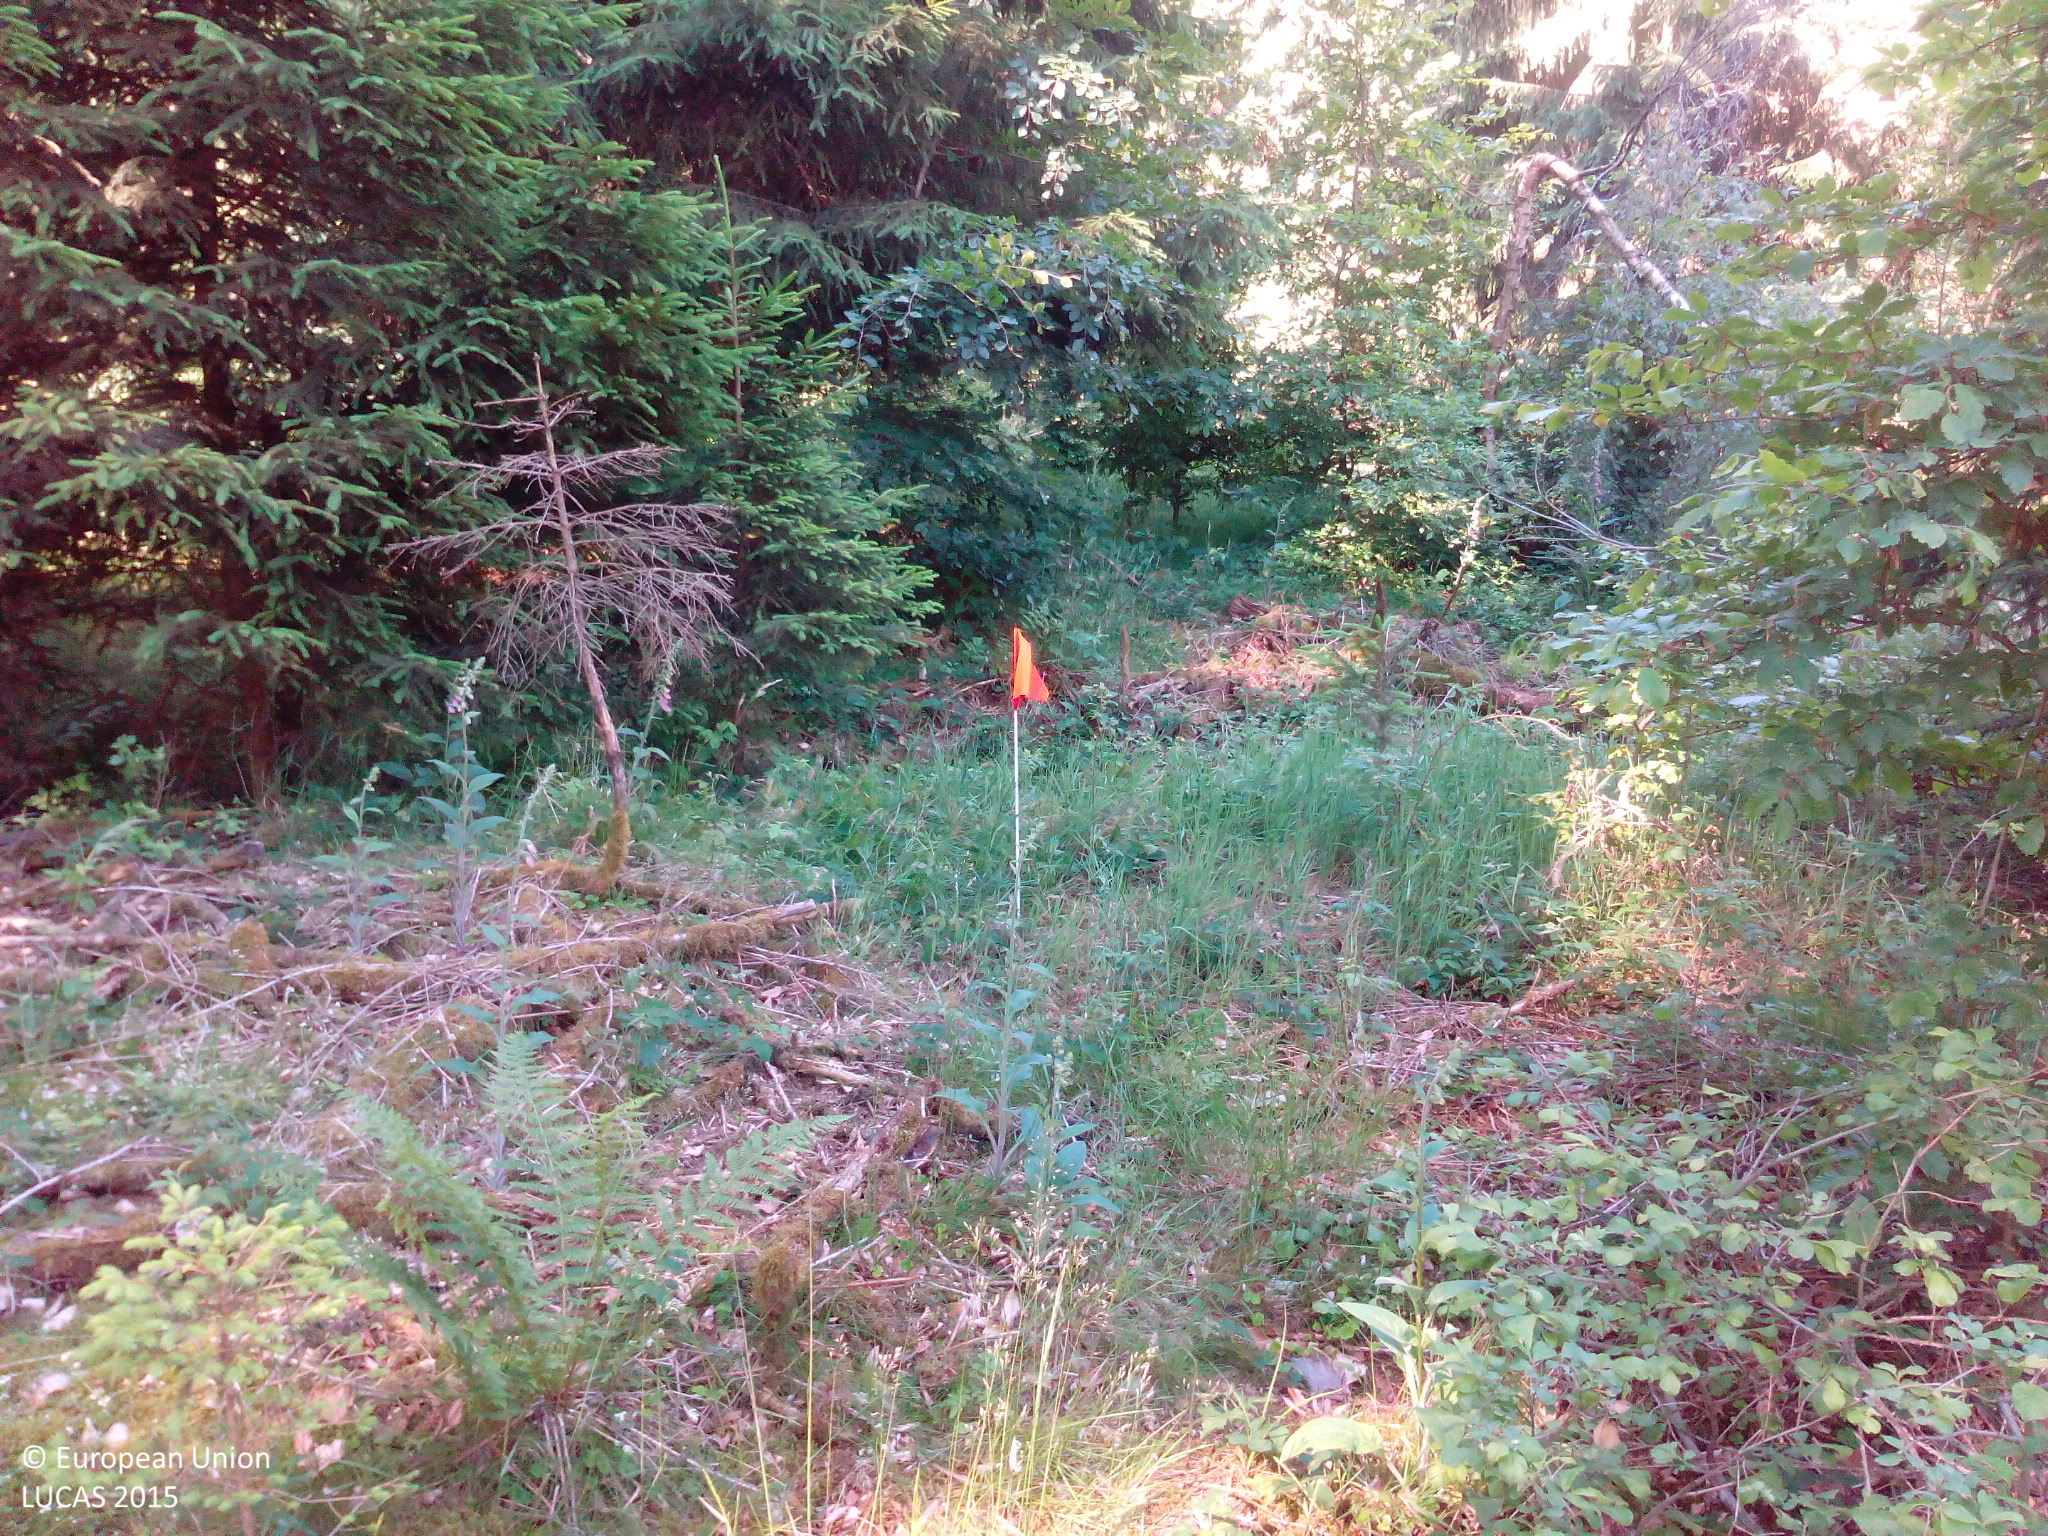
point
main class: Woodland
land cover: Spruce dominated coniferous woodland
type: hemiboreal forest and nemoral coniferous forest and mixed broadleaved-coniferous forest
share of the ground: 50 - 75 %
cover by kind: coniferous forest trees 60 %, herbaceous plants 15 %, lichens and mosses 15 %, broadleaved forest trees 5 %, unconsolidated bare surface 5 %
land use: Forestry
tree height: > 5 m
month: June
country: DE
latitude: 50.2459
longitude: 8.4719
